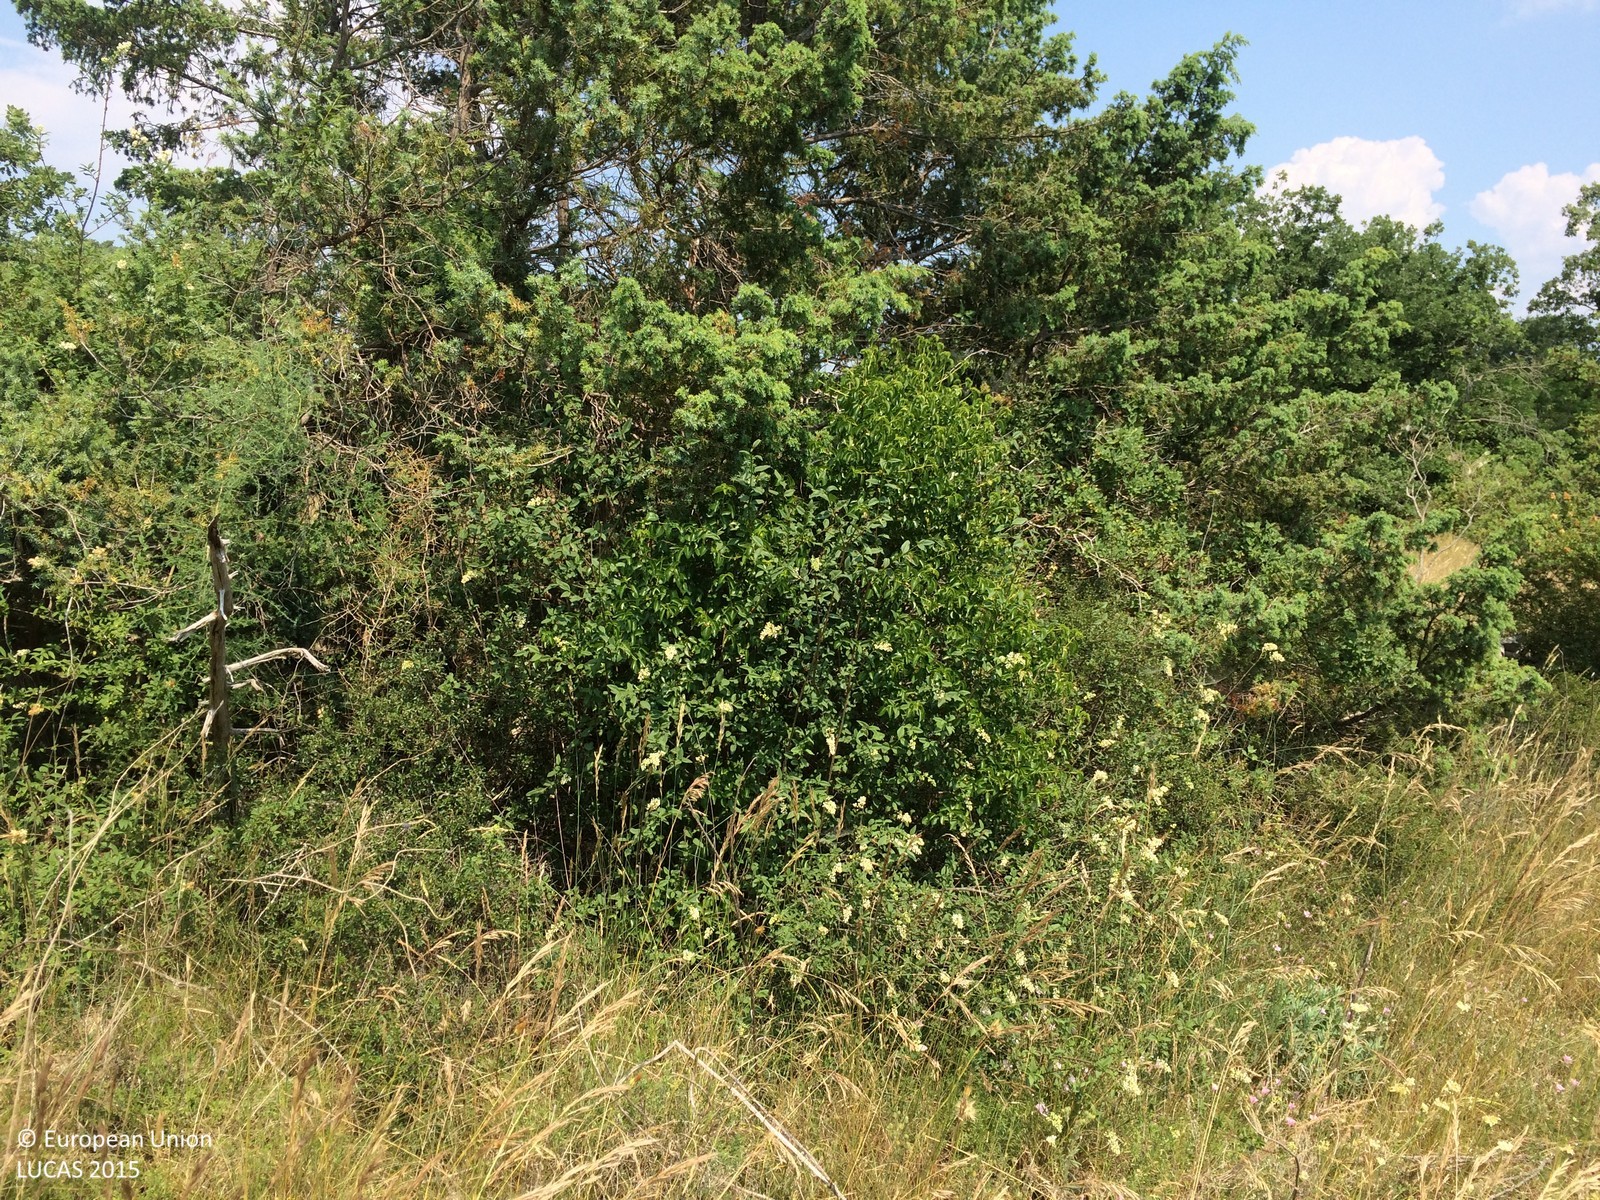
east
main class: Grassland
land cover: Grassland with sparse tree/shrub cover
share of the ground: > 75 %
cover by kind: herbaceous plants 90 %, broadleaved forest trees 5 %, shrubs 5 %
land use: Semi-natural and natural areas not in use
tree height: < 5 m
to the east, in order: Grassland with sparse tree/shrub cover; Dry stone walls; Grassland without tree/shrub cover; Single bushes/trees; Grassland without tree/shrub cover; Rocks and stones; Grassland without tree/shrub cover; Single bushes/trees; Grassland without tree/shrub cover; Tracks; Grassland without tree/shrub cover; Single bushes/trees; Grassland without tree/shrub cover; Grassland with sparse tree/shrub cover; Broadleaved woodland; Dry stone walls; Broadleaved woodland
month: June
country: HR
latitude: 45.0925
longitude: 13.8191
